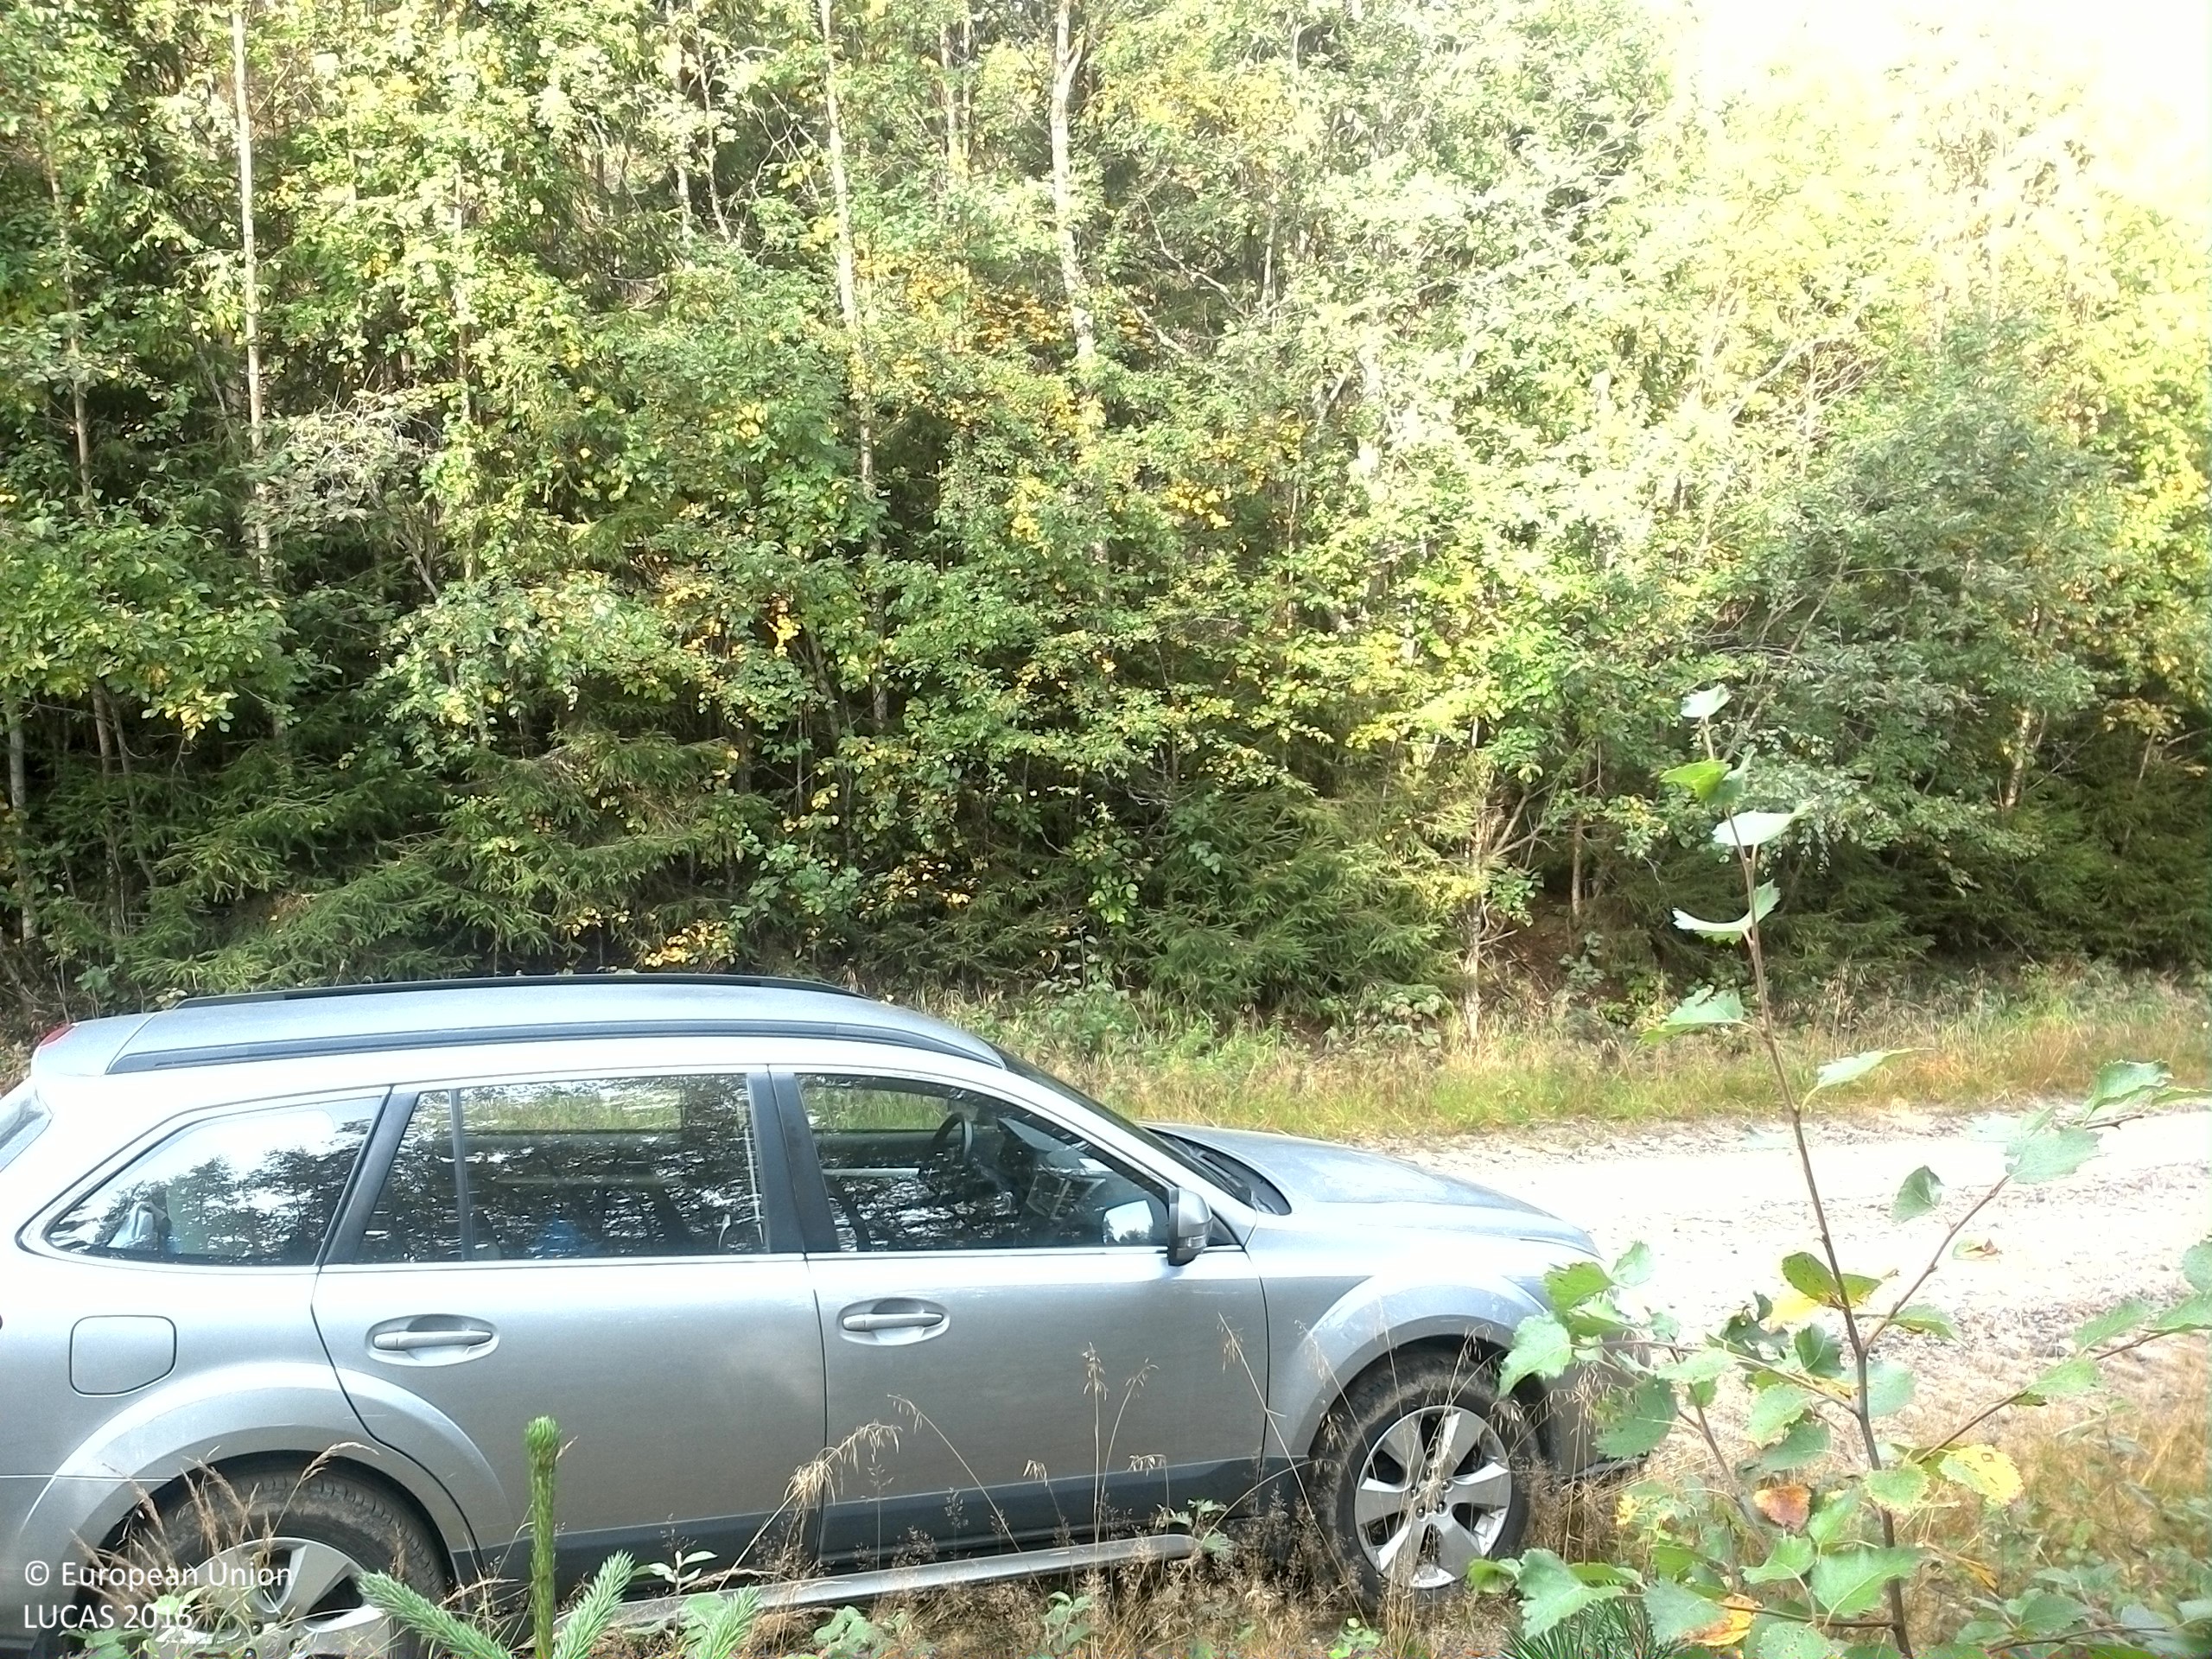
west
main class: Woodland
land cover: Other mixed woodland
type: boreal forest
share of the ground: 25 - 50 %
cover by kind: shrubs 30 %, coniferous forest trees 20 %, broadleaved forest trees 20 %, lichens and mosses 15 %, herbaceous plants 10 %, consolidated bare surface 5 %
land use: Forestry
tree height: > 5 m
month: September
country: SE
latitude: 61.6316
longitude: 15.3605
